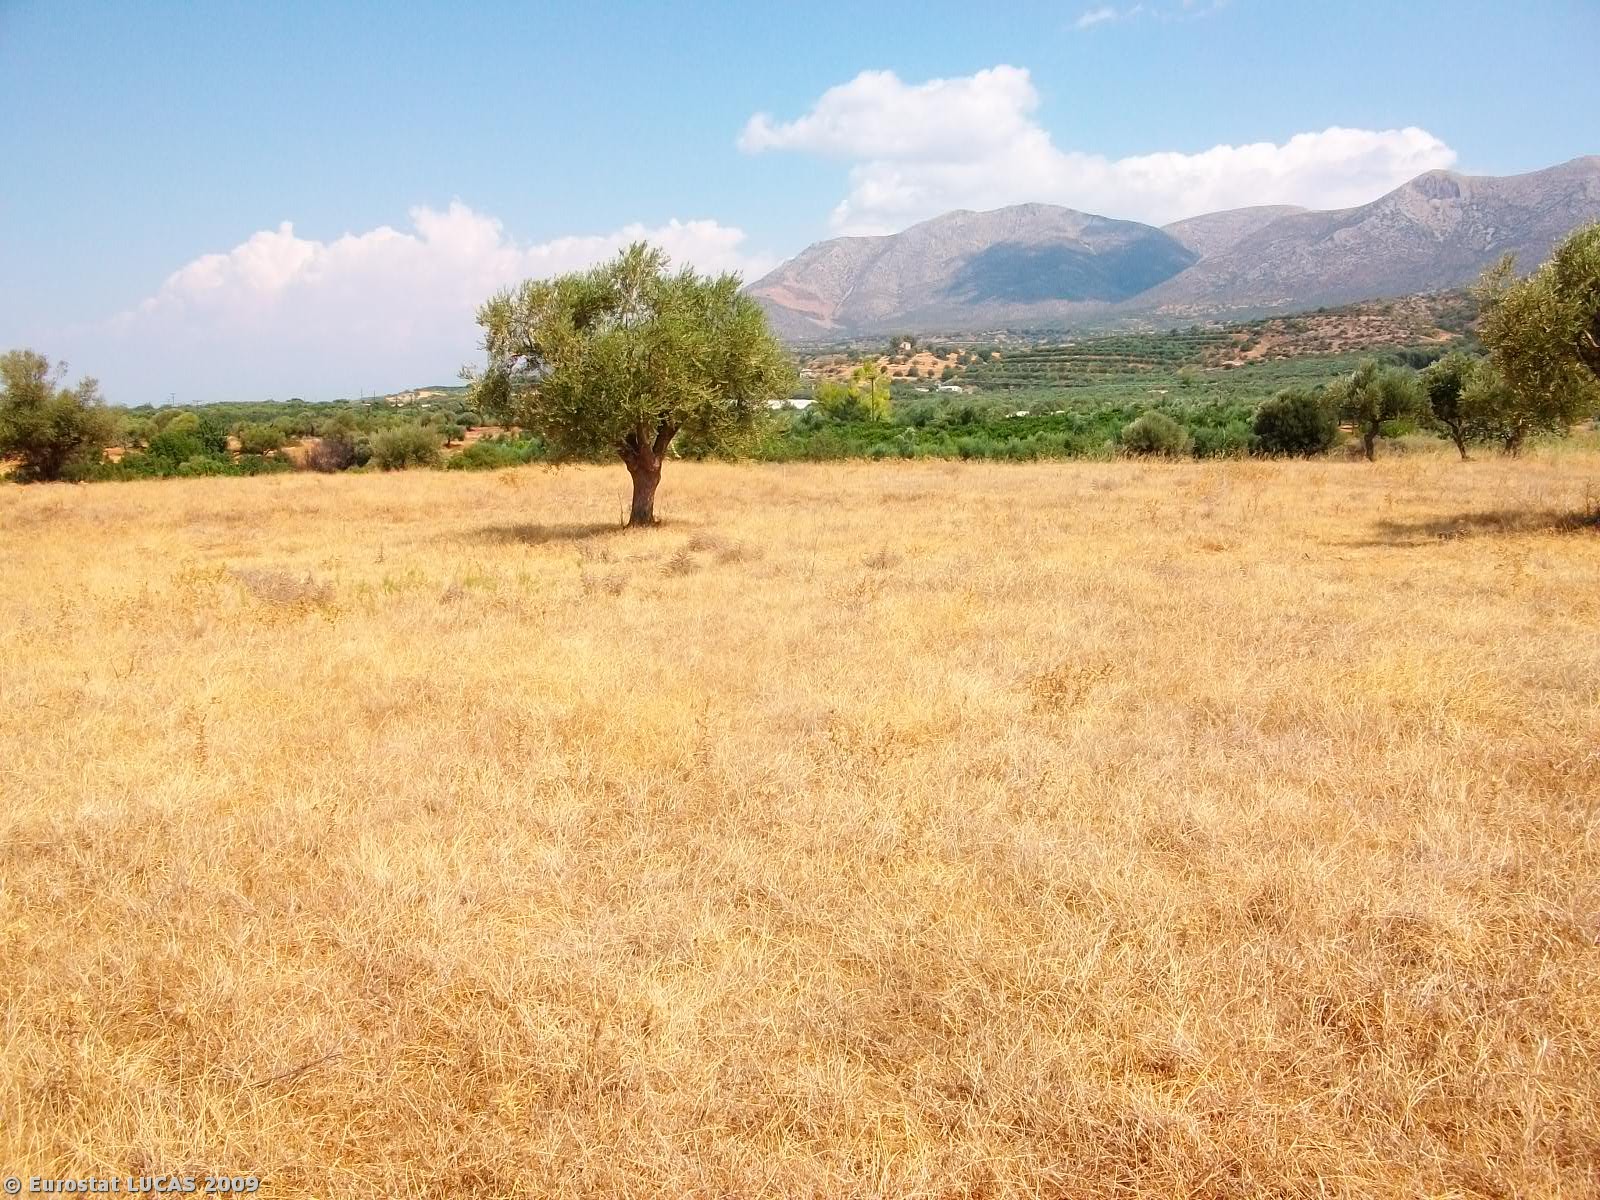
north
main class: Grassland
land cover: Grassland with sparse tree/shrub cover
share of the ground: > 75 %
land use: Agriculture (excluding fallow land and kitchen gardens)
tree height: < 5 m
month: August
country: GR
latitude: 36.7681
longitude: 22.8038
